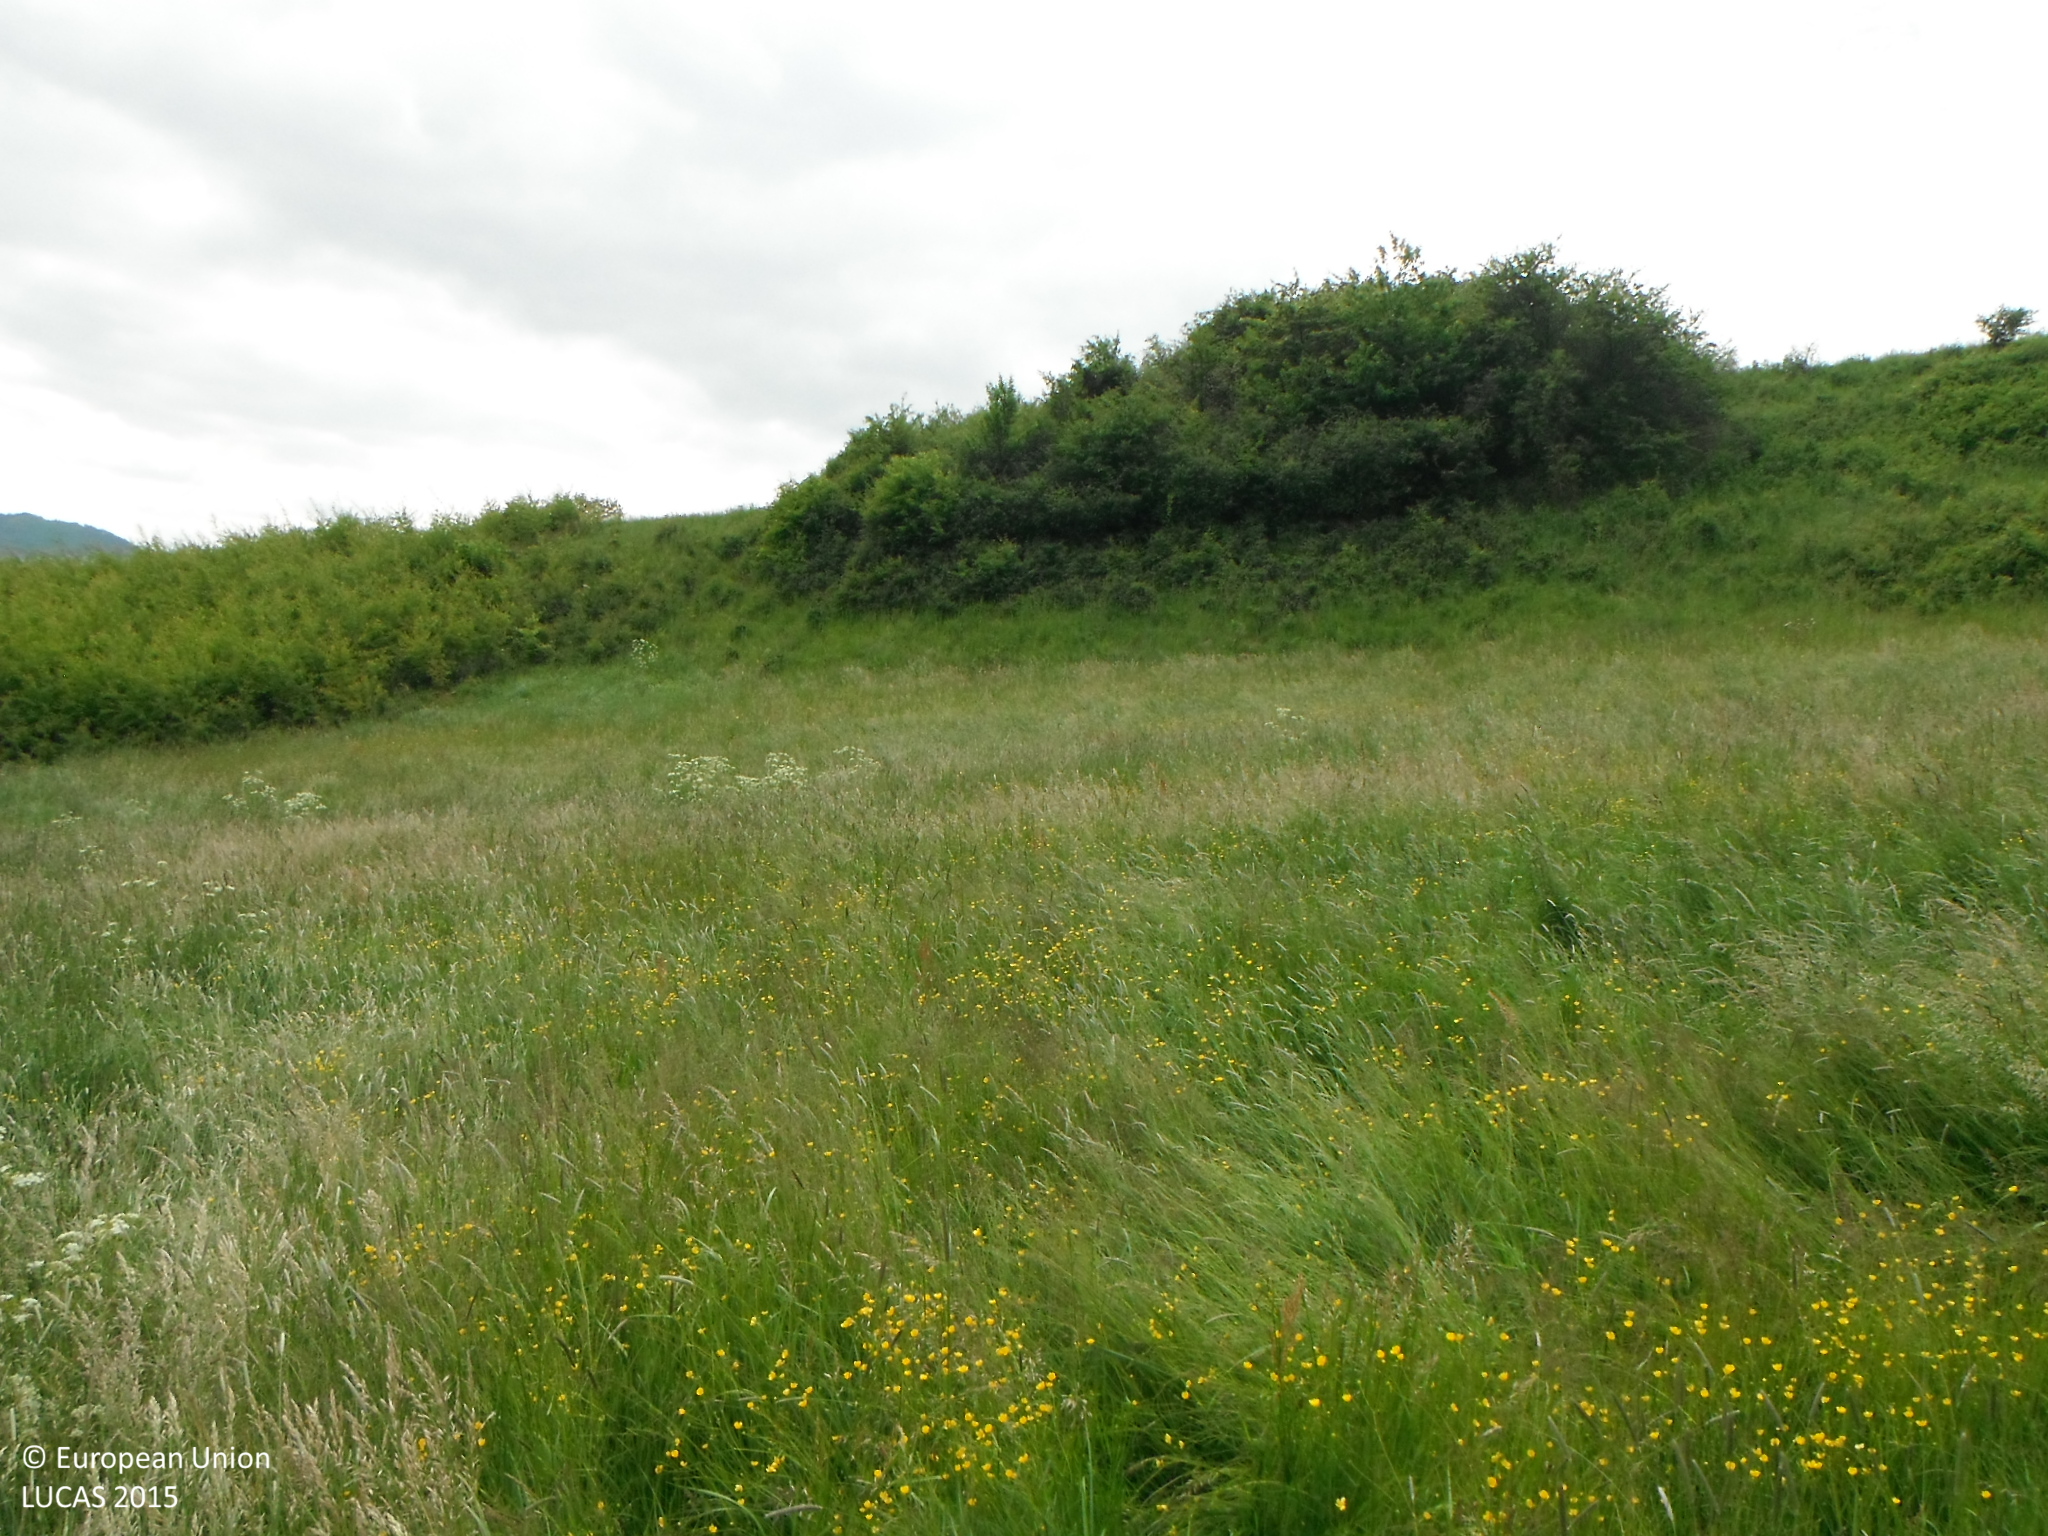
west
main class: Grassland
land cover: Grassland without tree/shrub cover
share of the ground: > 75 %
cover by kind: herbaceous plants 100 %
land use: Agriculture (excluding fallow land and kitchen gardens)
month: May
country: SK
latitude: 48.4400
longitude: 18.9281
